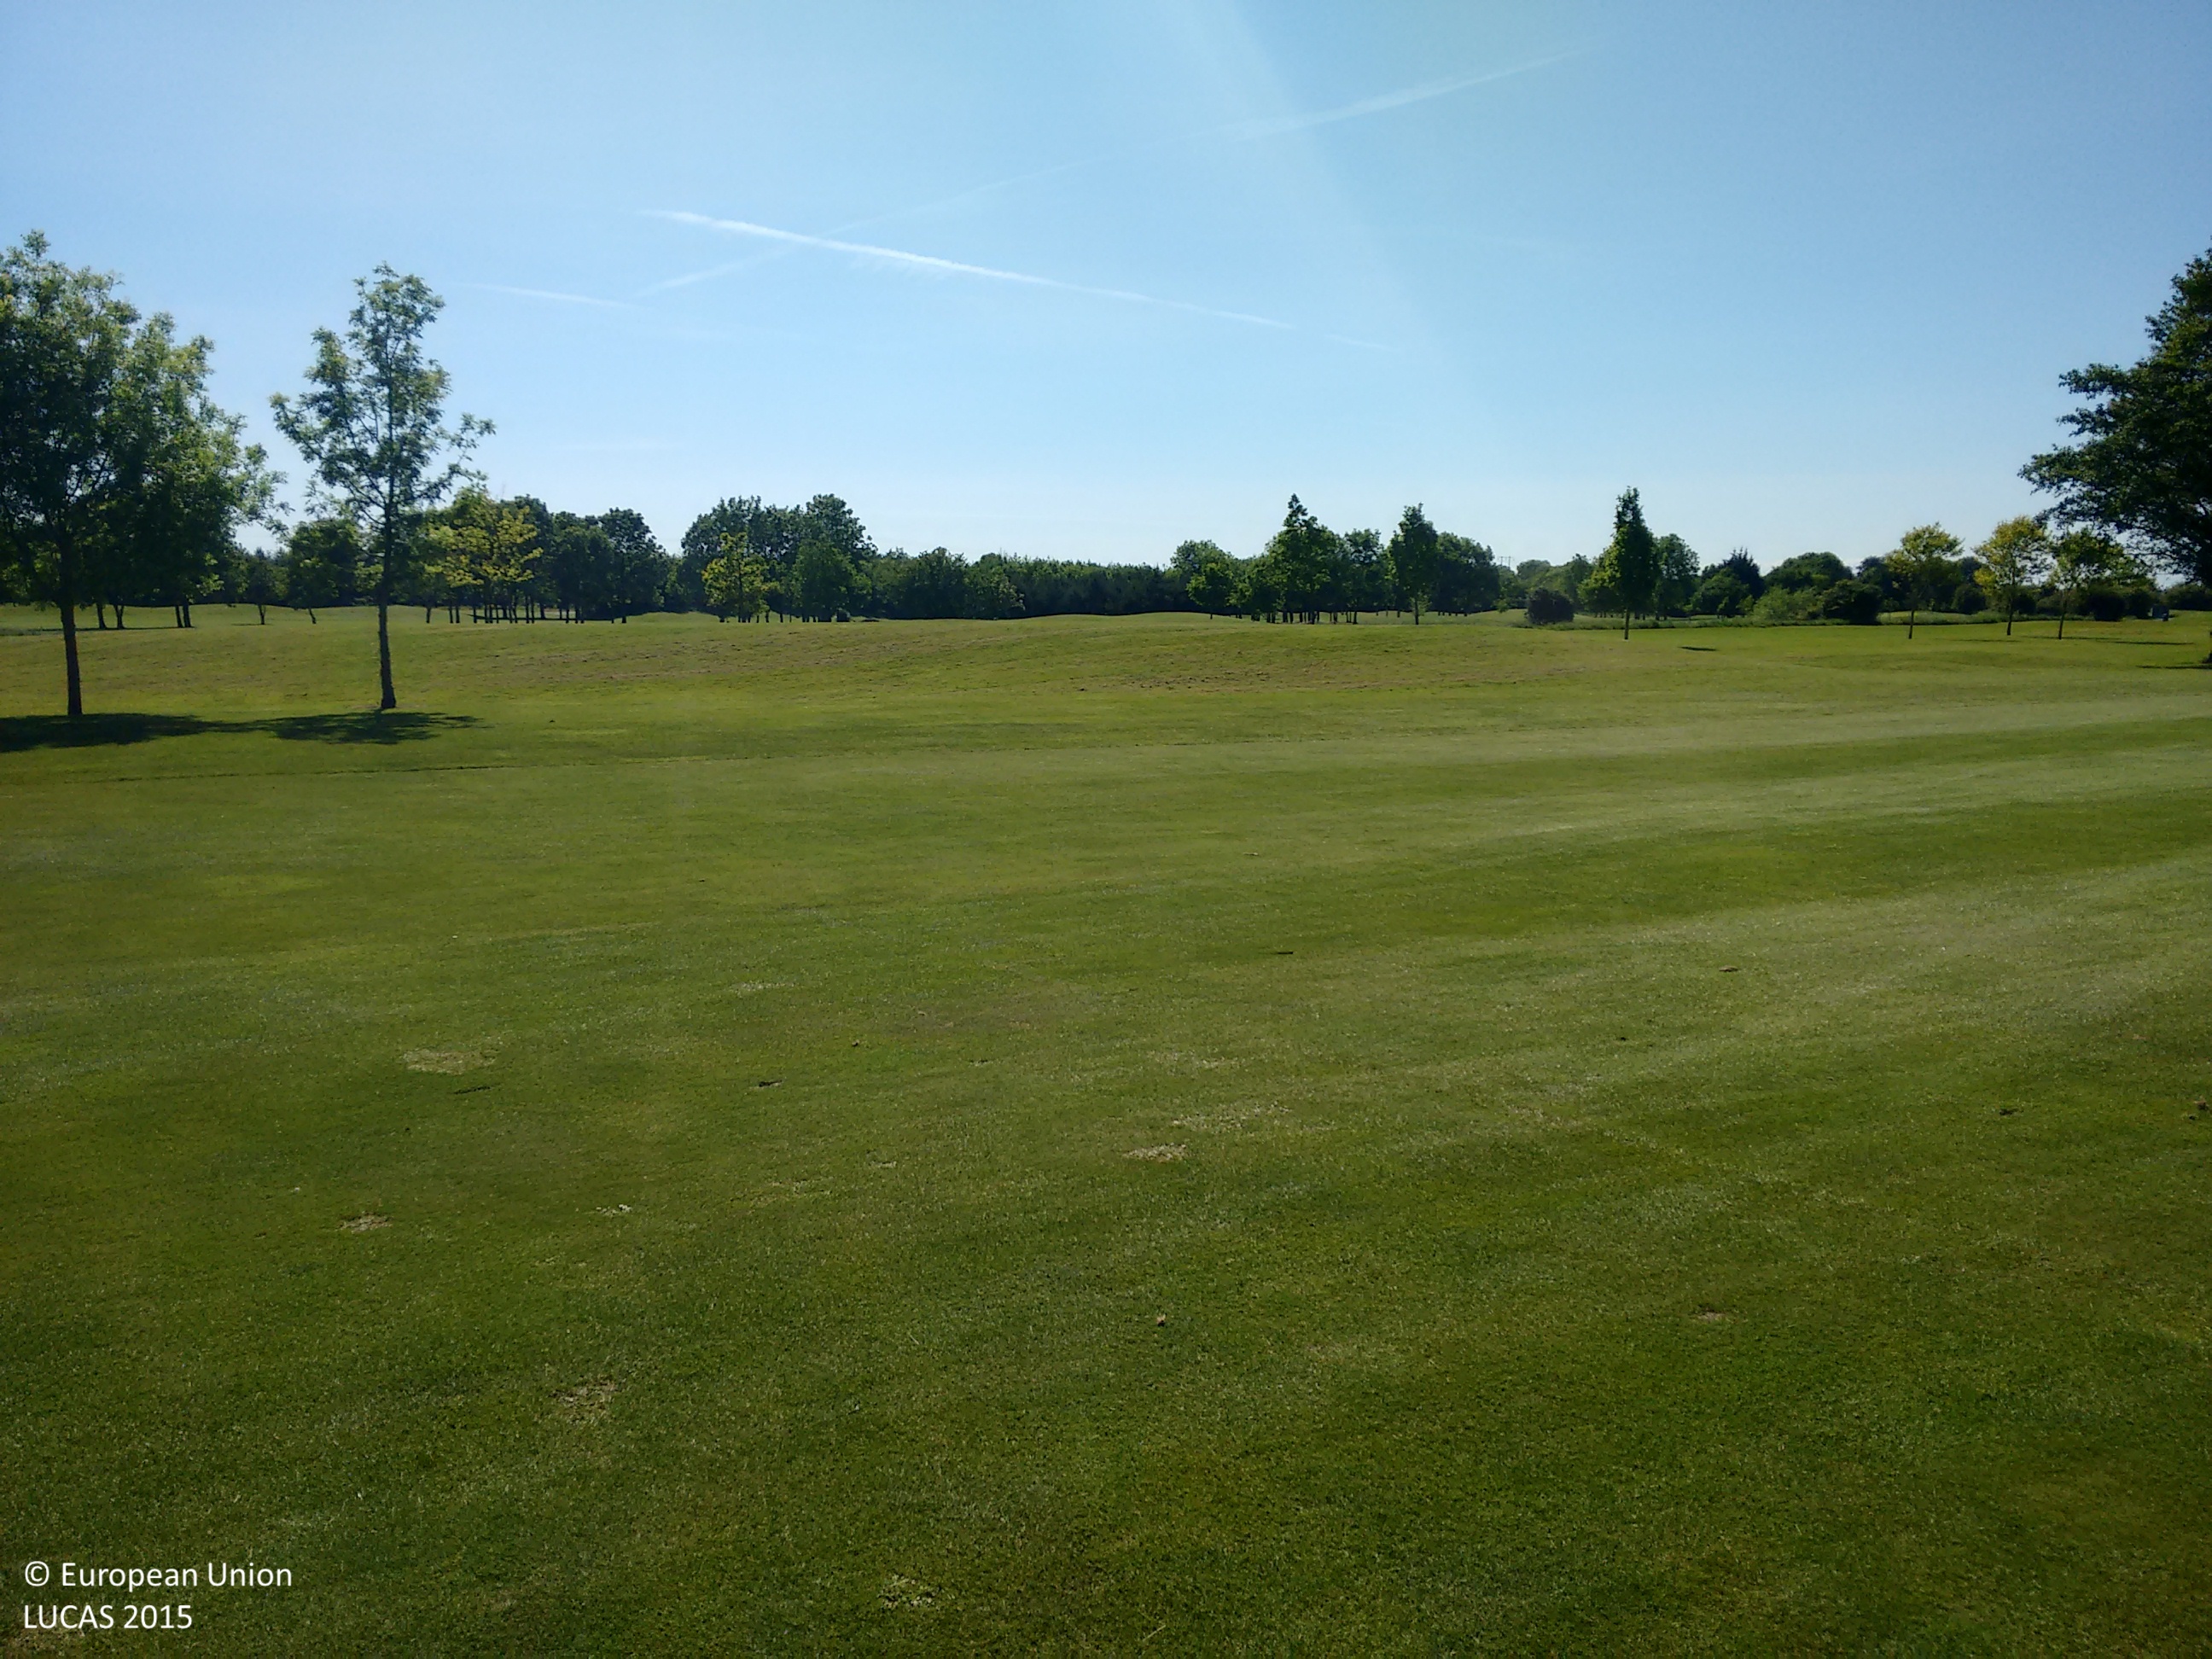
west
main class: Grassland
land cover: Grassland with sparse tree/shrub cover
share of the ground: > 75 %
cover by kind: herbaceous plants 90 %, broadleaved forest trees 5 %, shrubs 5 %
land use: Sport
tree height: < 5 m
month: June
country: IE
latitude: 53.4860
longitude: -6.2602
